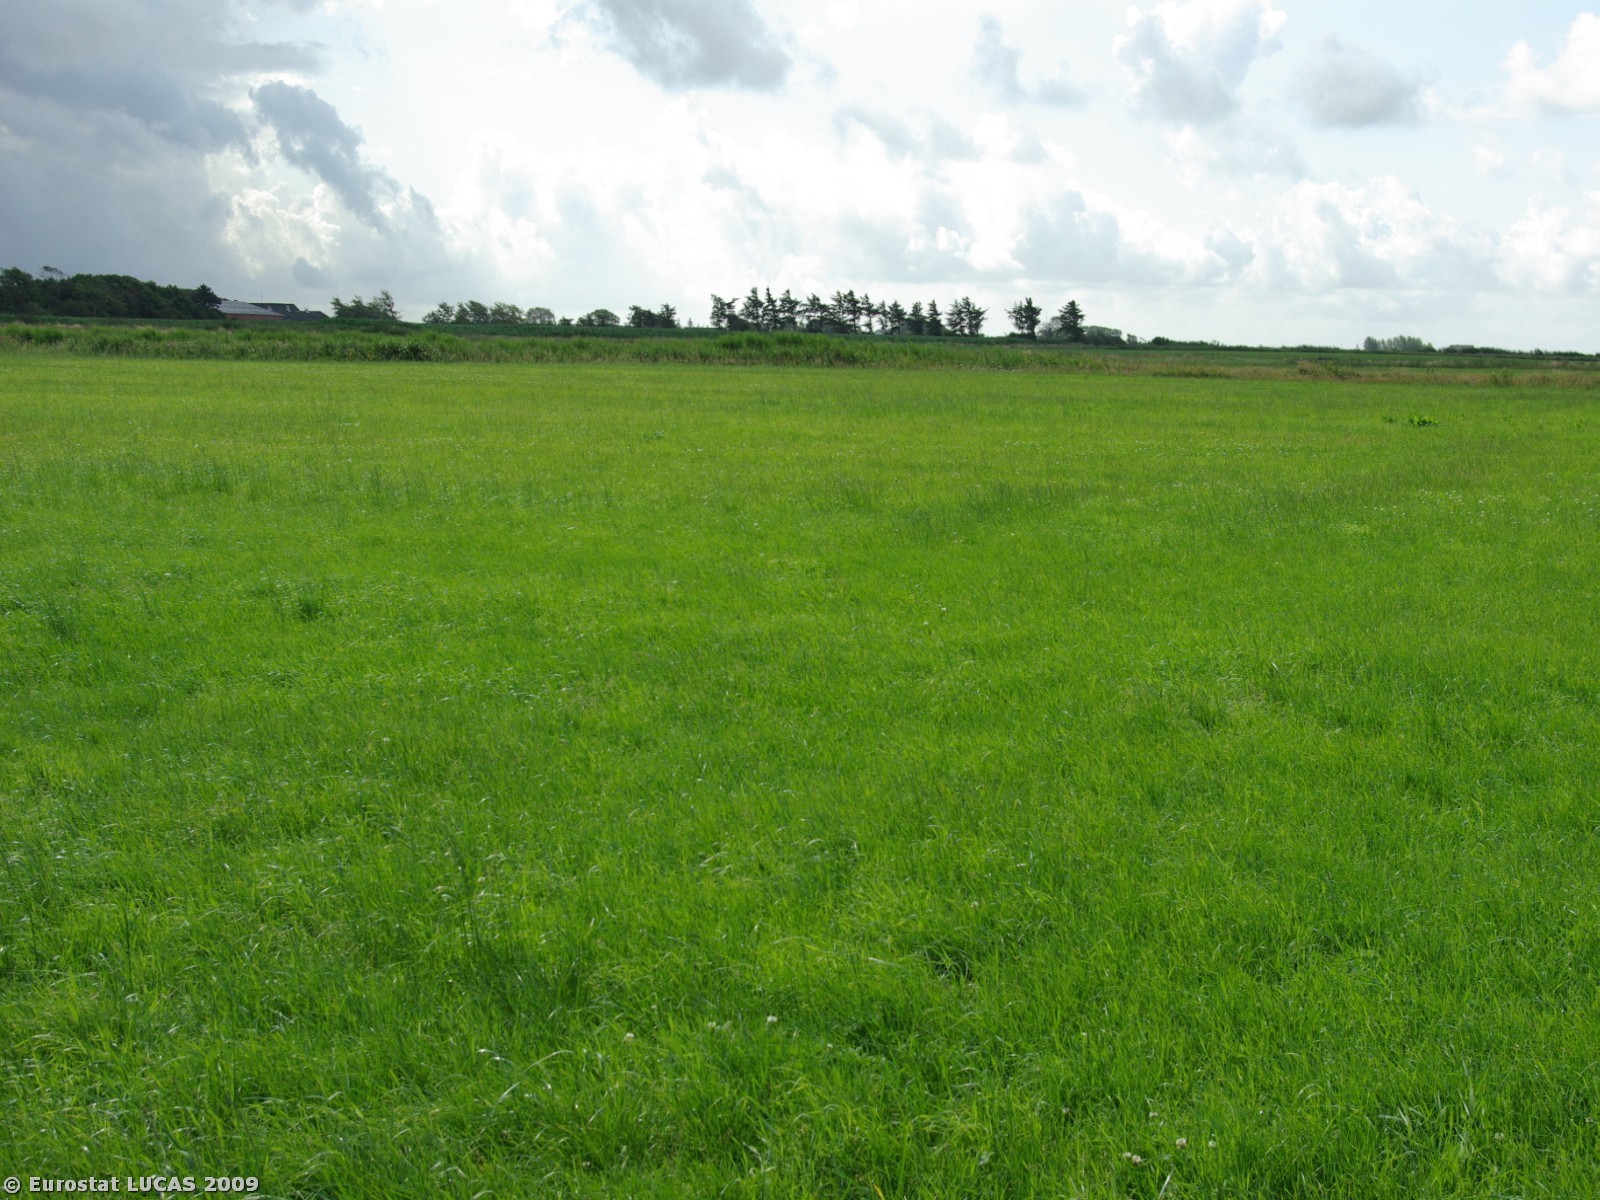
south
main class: Grassland
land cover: Grassland without tree/shrub cover
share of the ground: > 75 %
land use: Agriculture (excluding fallow land and kitchen gardens)
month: July
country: DK
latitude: 54.9771
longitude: 8.7354
